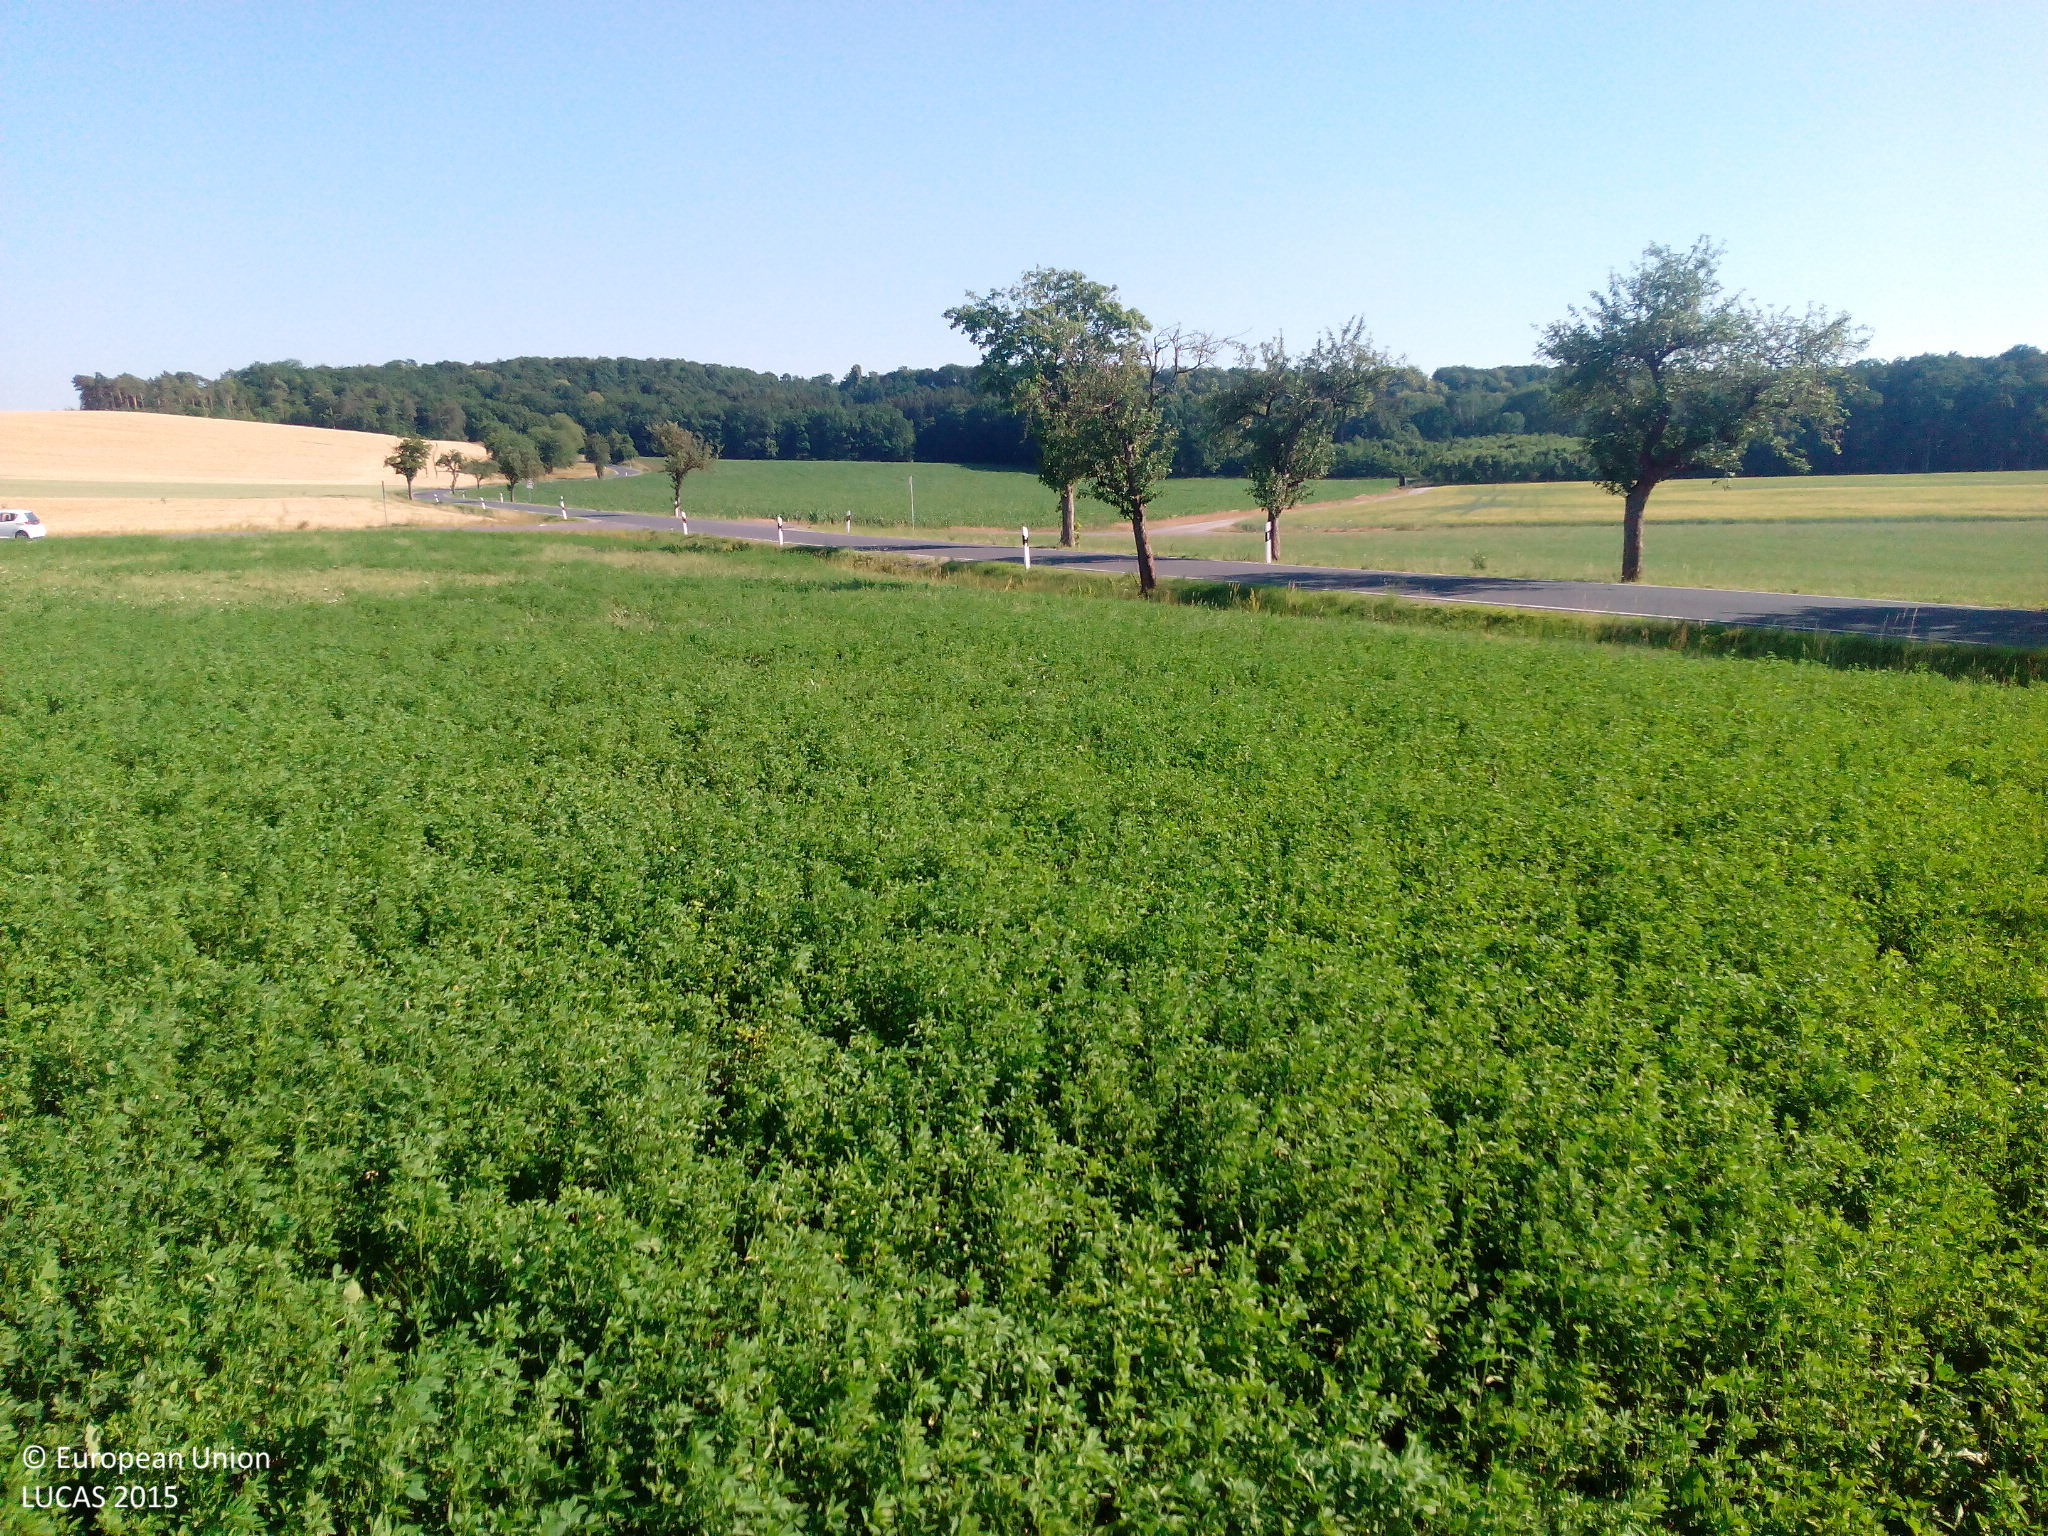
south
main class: Cropland
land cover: Lucerne
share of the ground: > 75 %
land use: Agriculture (excluding fallow land and kitchen gardens)
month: July
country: DE
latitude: 50.2904
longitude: 10.6314
